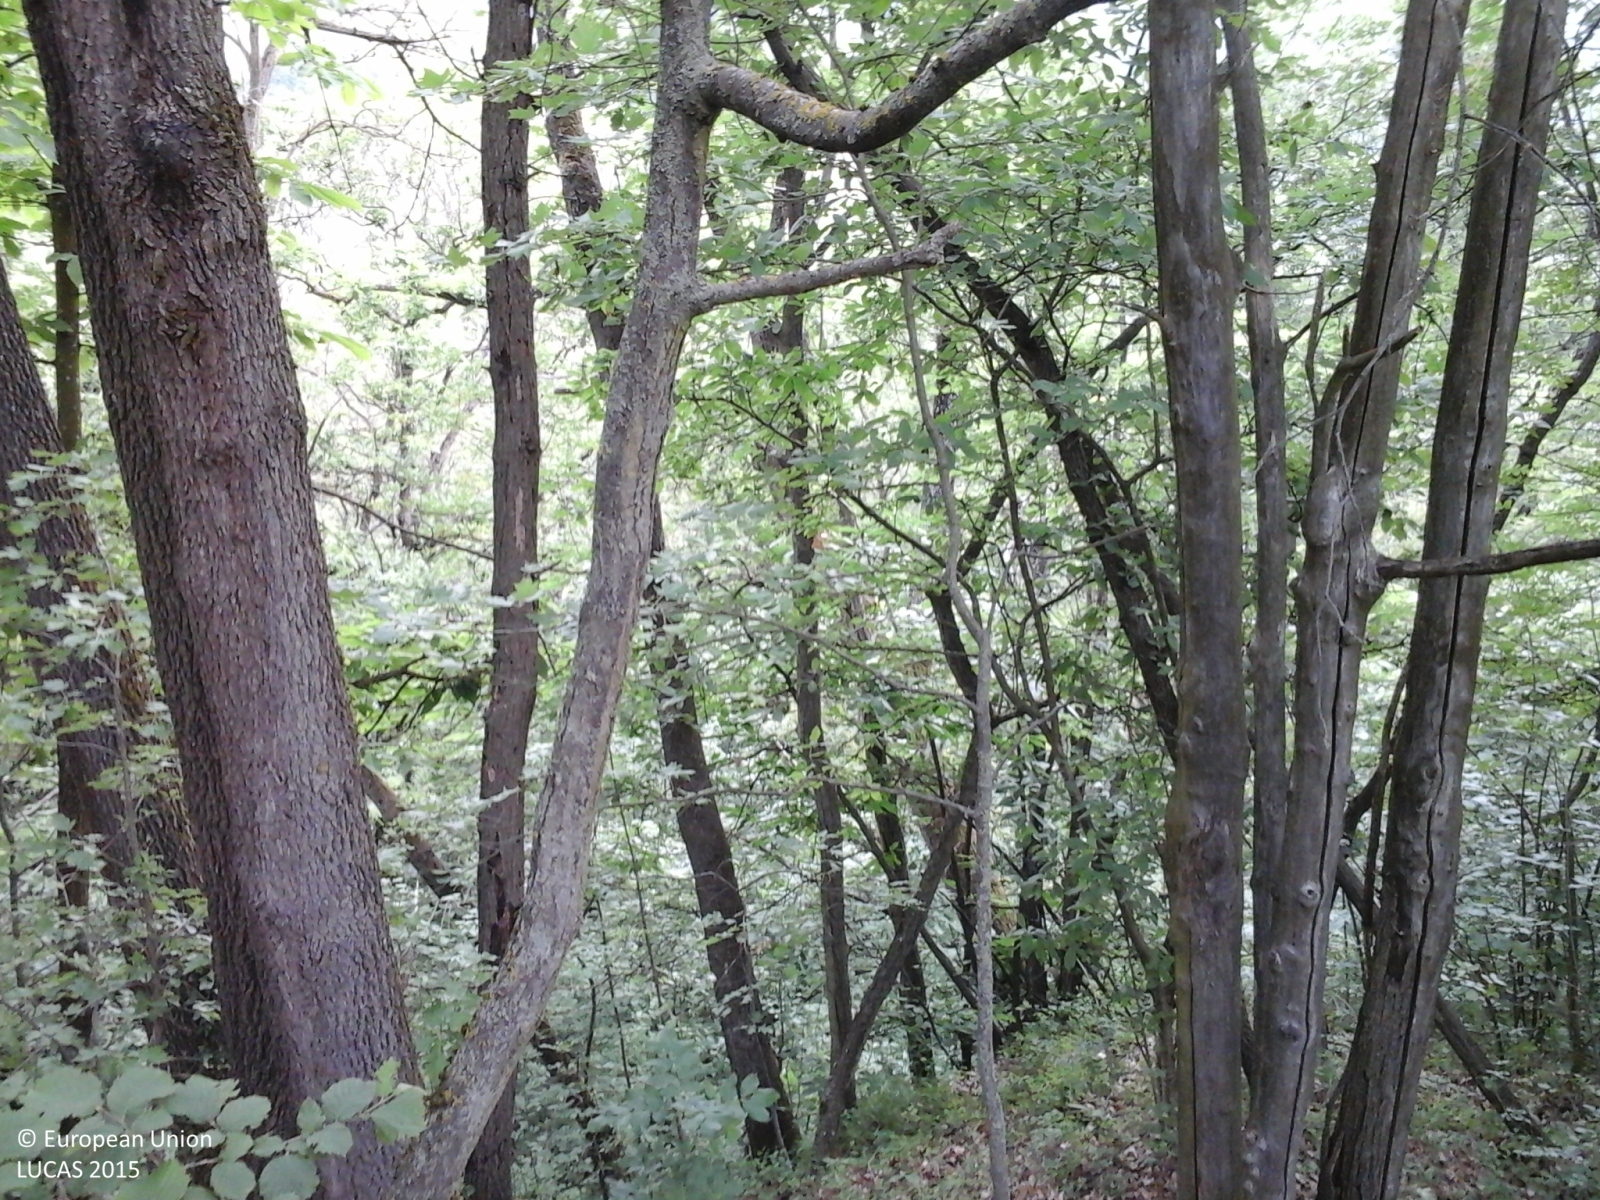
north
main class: Woodland
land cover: Broadleaved woodland
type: thermophilous deciduous forest
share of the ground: > 75 %
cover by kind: broadleaved forest trees 90 %, shrubs 10 %
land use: Forestry
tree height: > 5 m
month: May
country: IT
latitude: 44.6810
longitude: 8.4011
